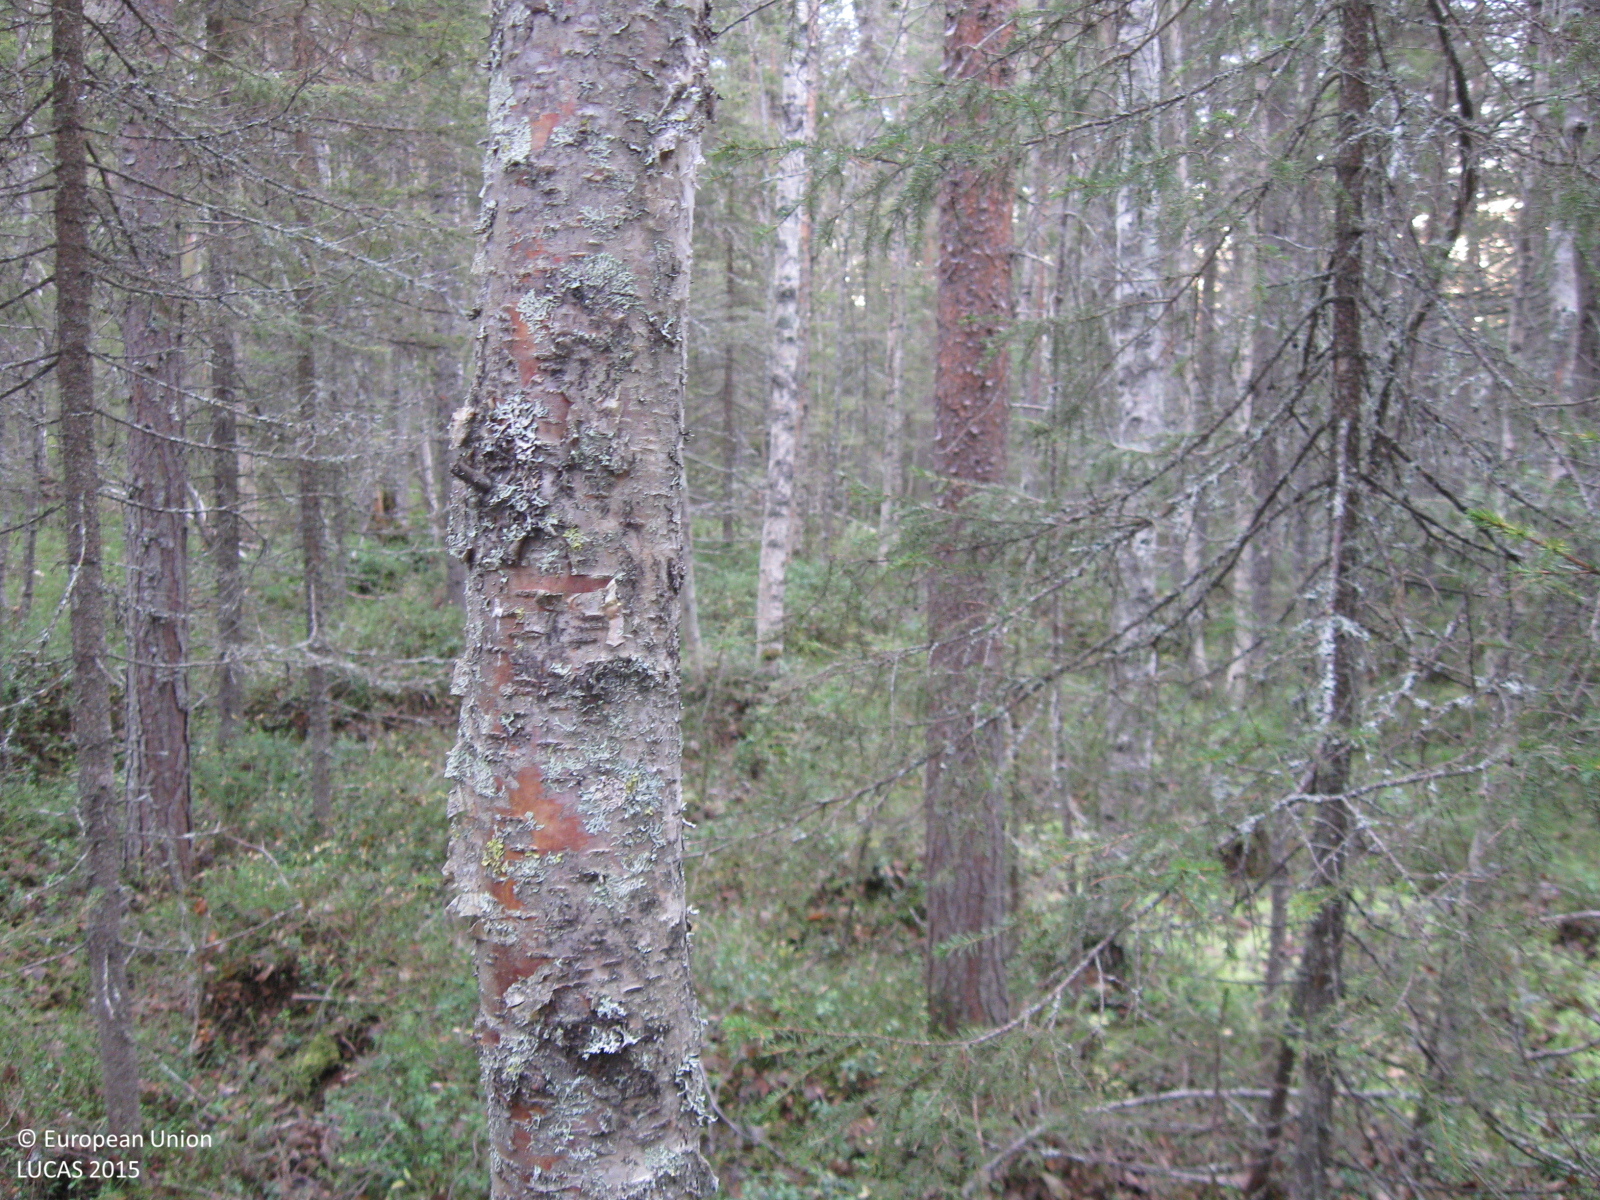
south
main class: Woodland
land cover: Other mixed woodland
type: boreal forest
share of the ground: > 75 %
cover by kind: coniferous forest trees 60 %, broadleaved forest trees 20 %, shrubs 10 %, herbaceous plants 5 %, lichens and mosses 5 %
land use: Forestry
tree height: > 5 m
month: October
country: SE
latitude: 66.1740
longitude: 21.5248
